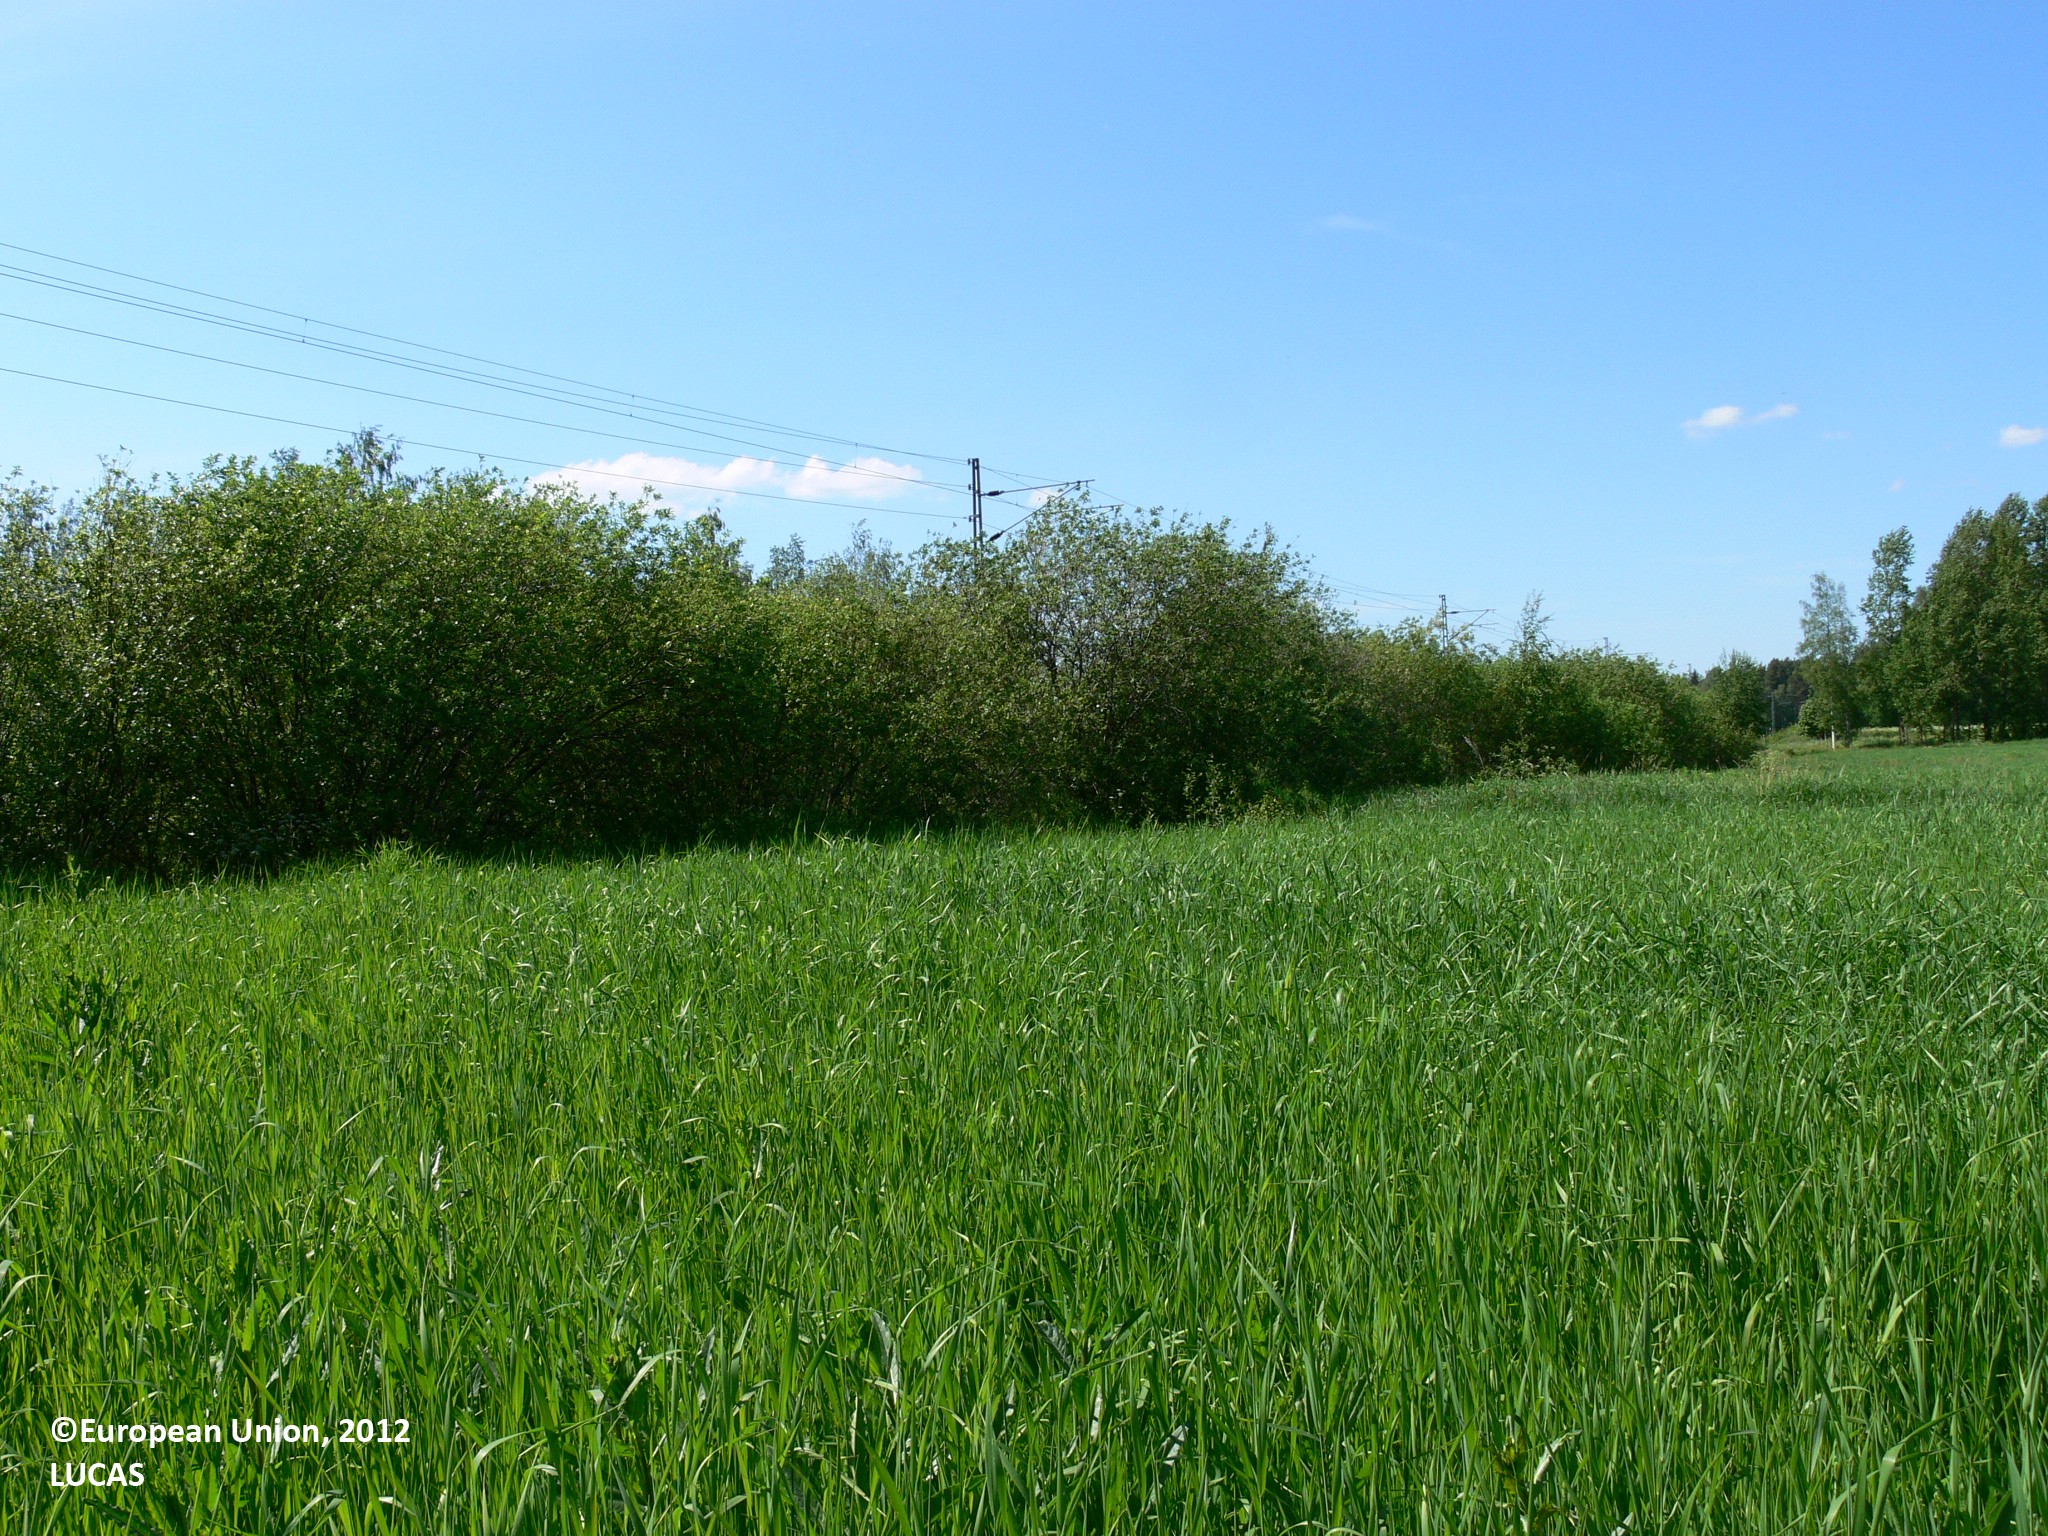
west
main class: Cropland
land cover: Temporary grasslands
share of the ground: > 75 %
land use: Agriculture (excluding fallow land and kitchen gardens)
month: June
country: FI
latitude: 62.5653
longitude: 29.8036
